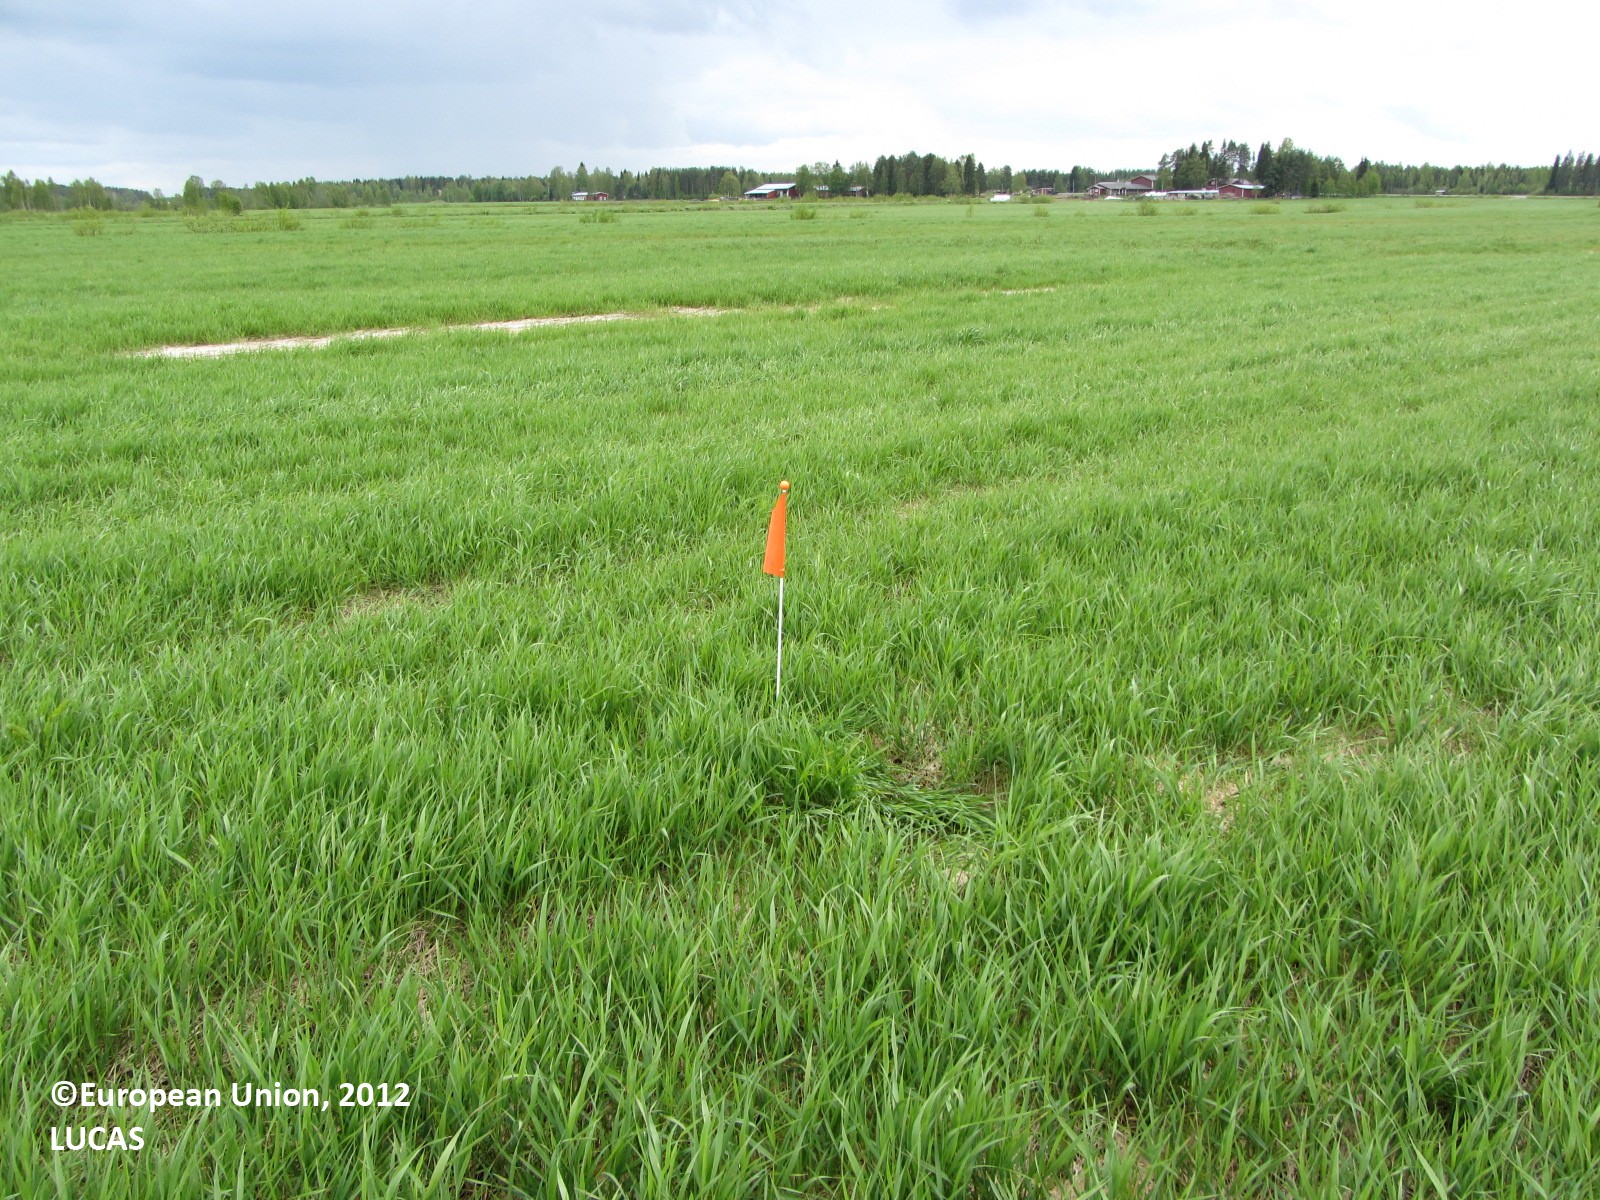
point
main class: Cropland
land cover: Barley
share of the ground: > 75 %
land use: Agriculture (excluding fallow land and kitchen gardens)
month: June
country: FI
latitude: 63.8240
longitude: 24.6476
